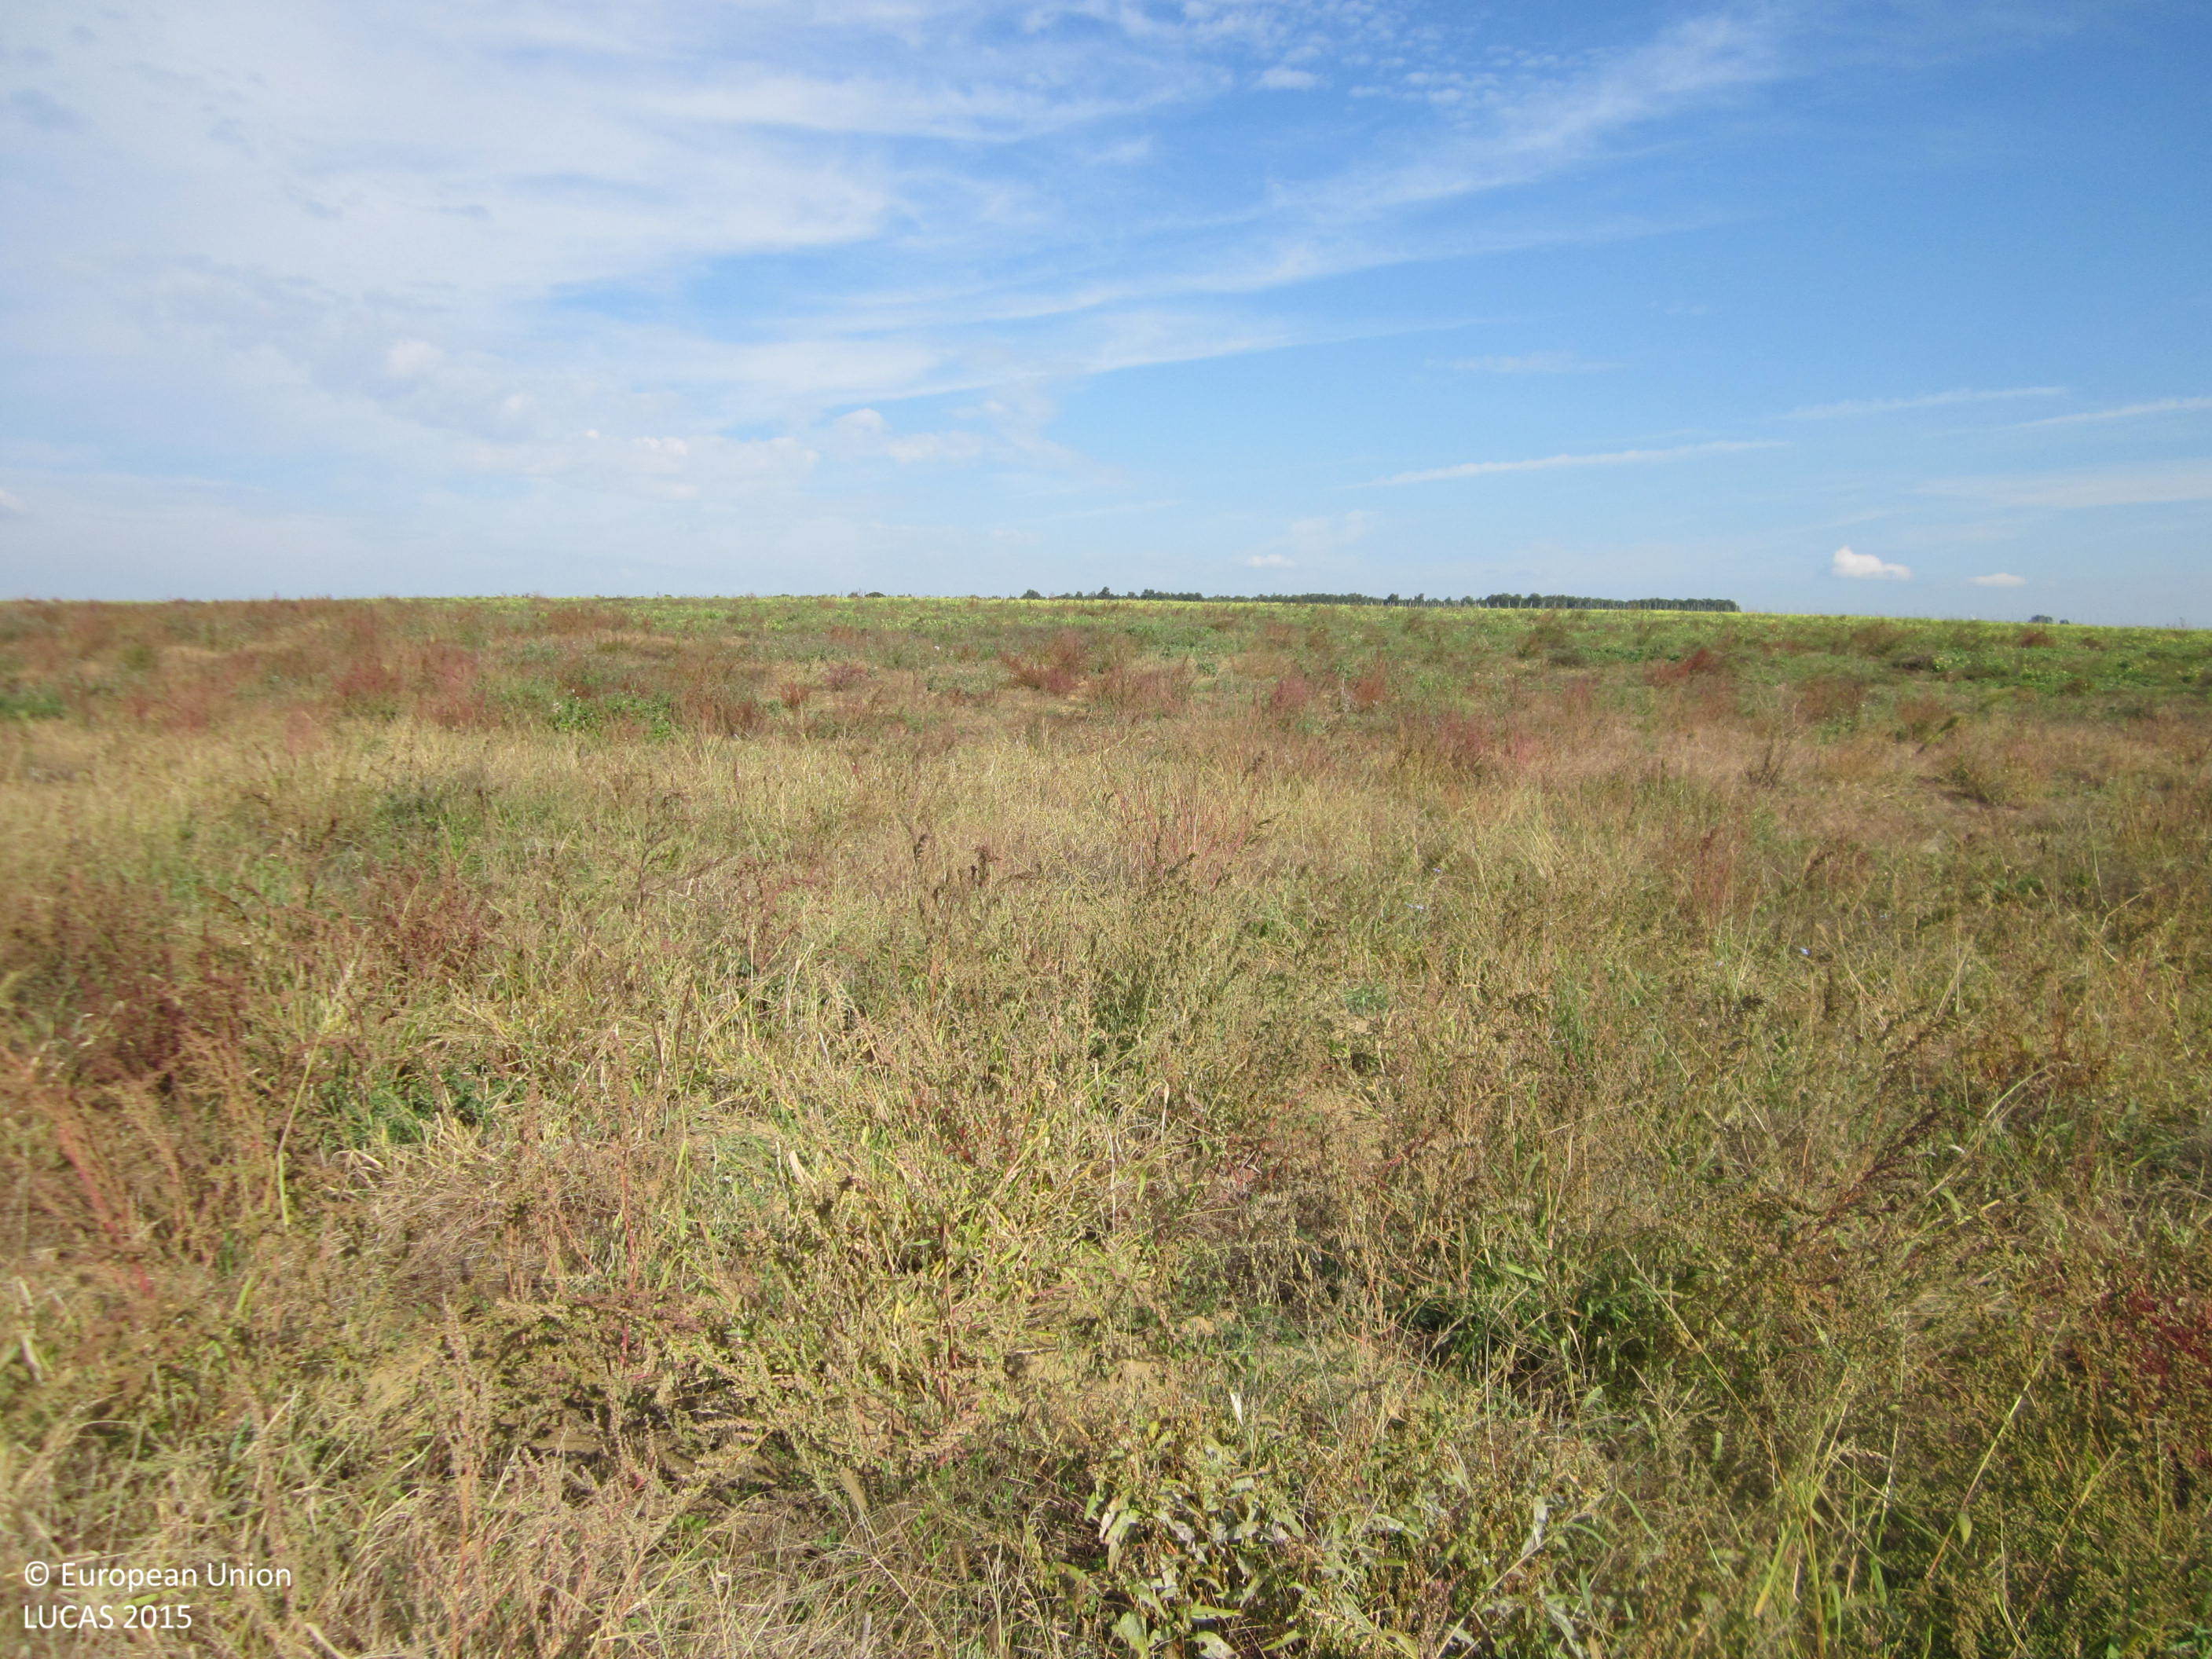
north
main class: Grassland
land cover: Spontaneously vegetated surfaces
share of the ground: > 75 %
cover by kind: herbaceous plants 100 %
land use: Semi-natural and natural areas not in use
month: October
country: BG
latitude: 42.7947
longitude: 26.7417
